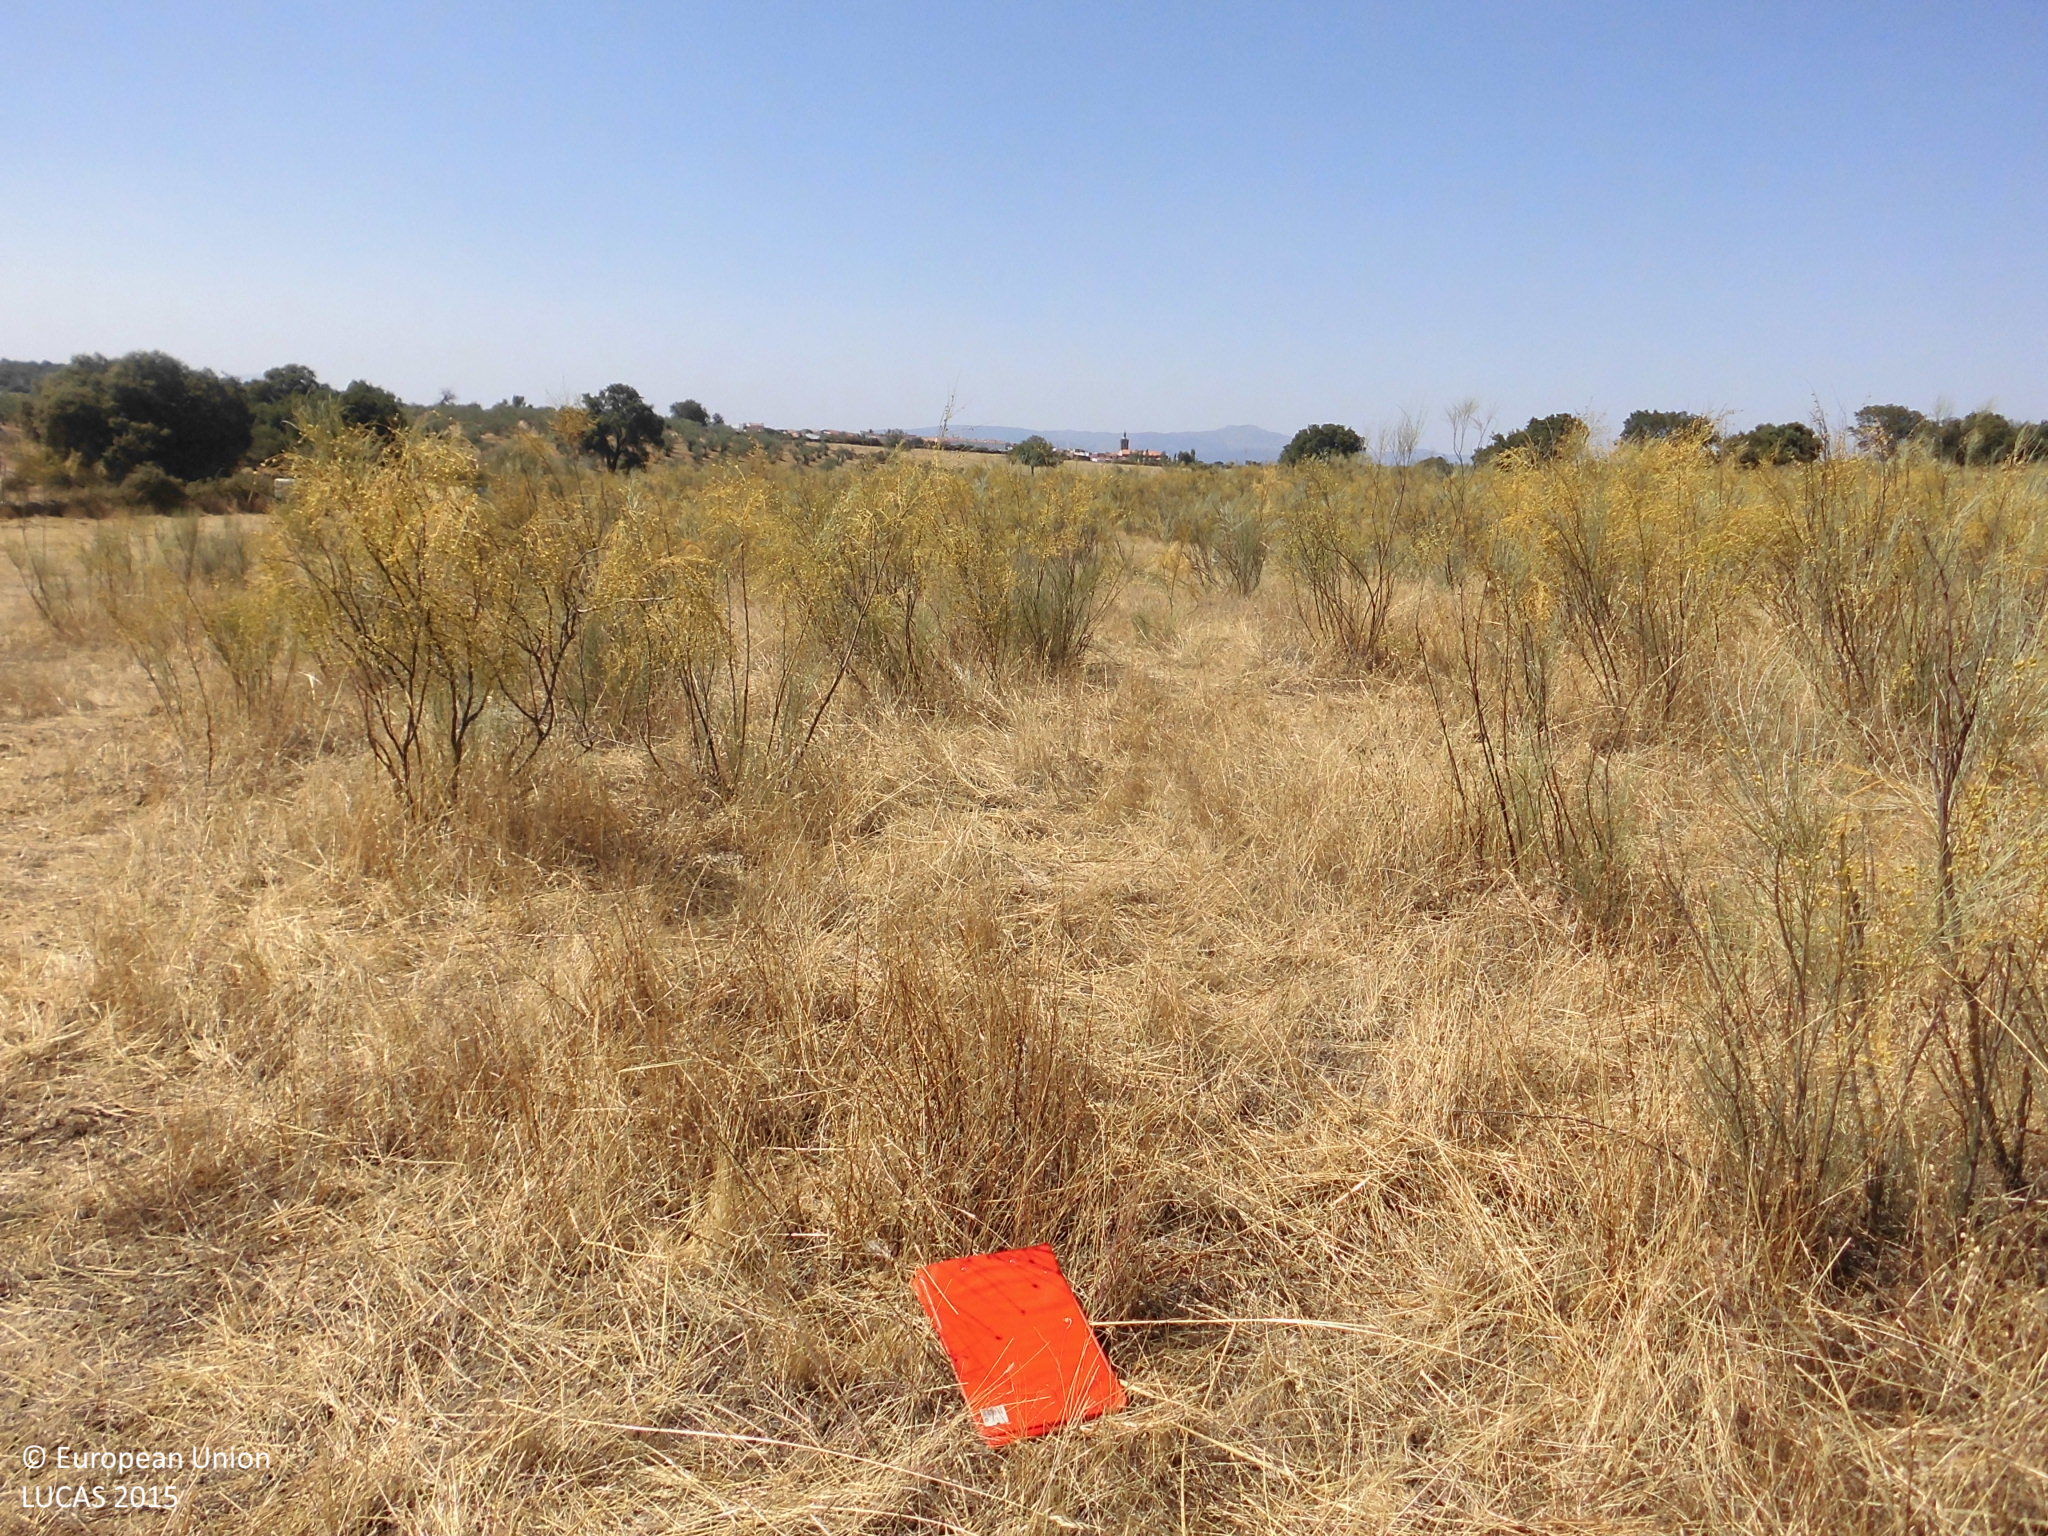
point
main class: Shrubland
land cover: Shrubland without tree cover
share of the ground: 50 - 75 %
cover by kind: shrubs 60 %, herbaceous plants 40 %
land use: Agriculture (excluding fallow land and kitchen gardens)
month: July
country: ES
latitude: 40.0520
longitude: -6.5271
